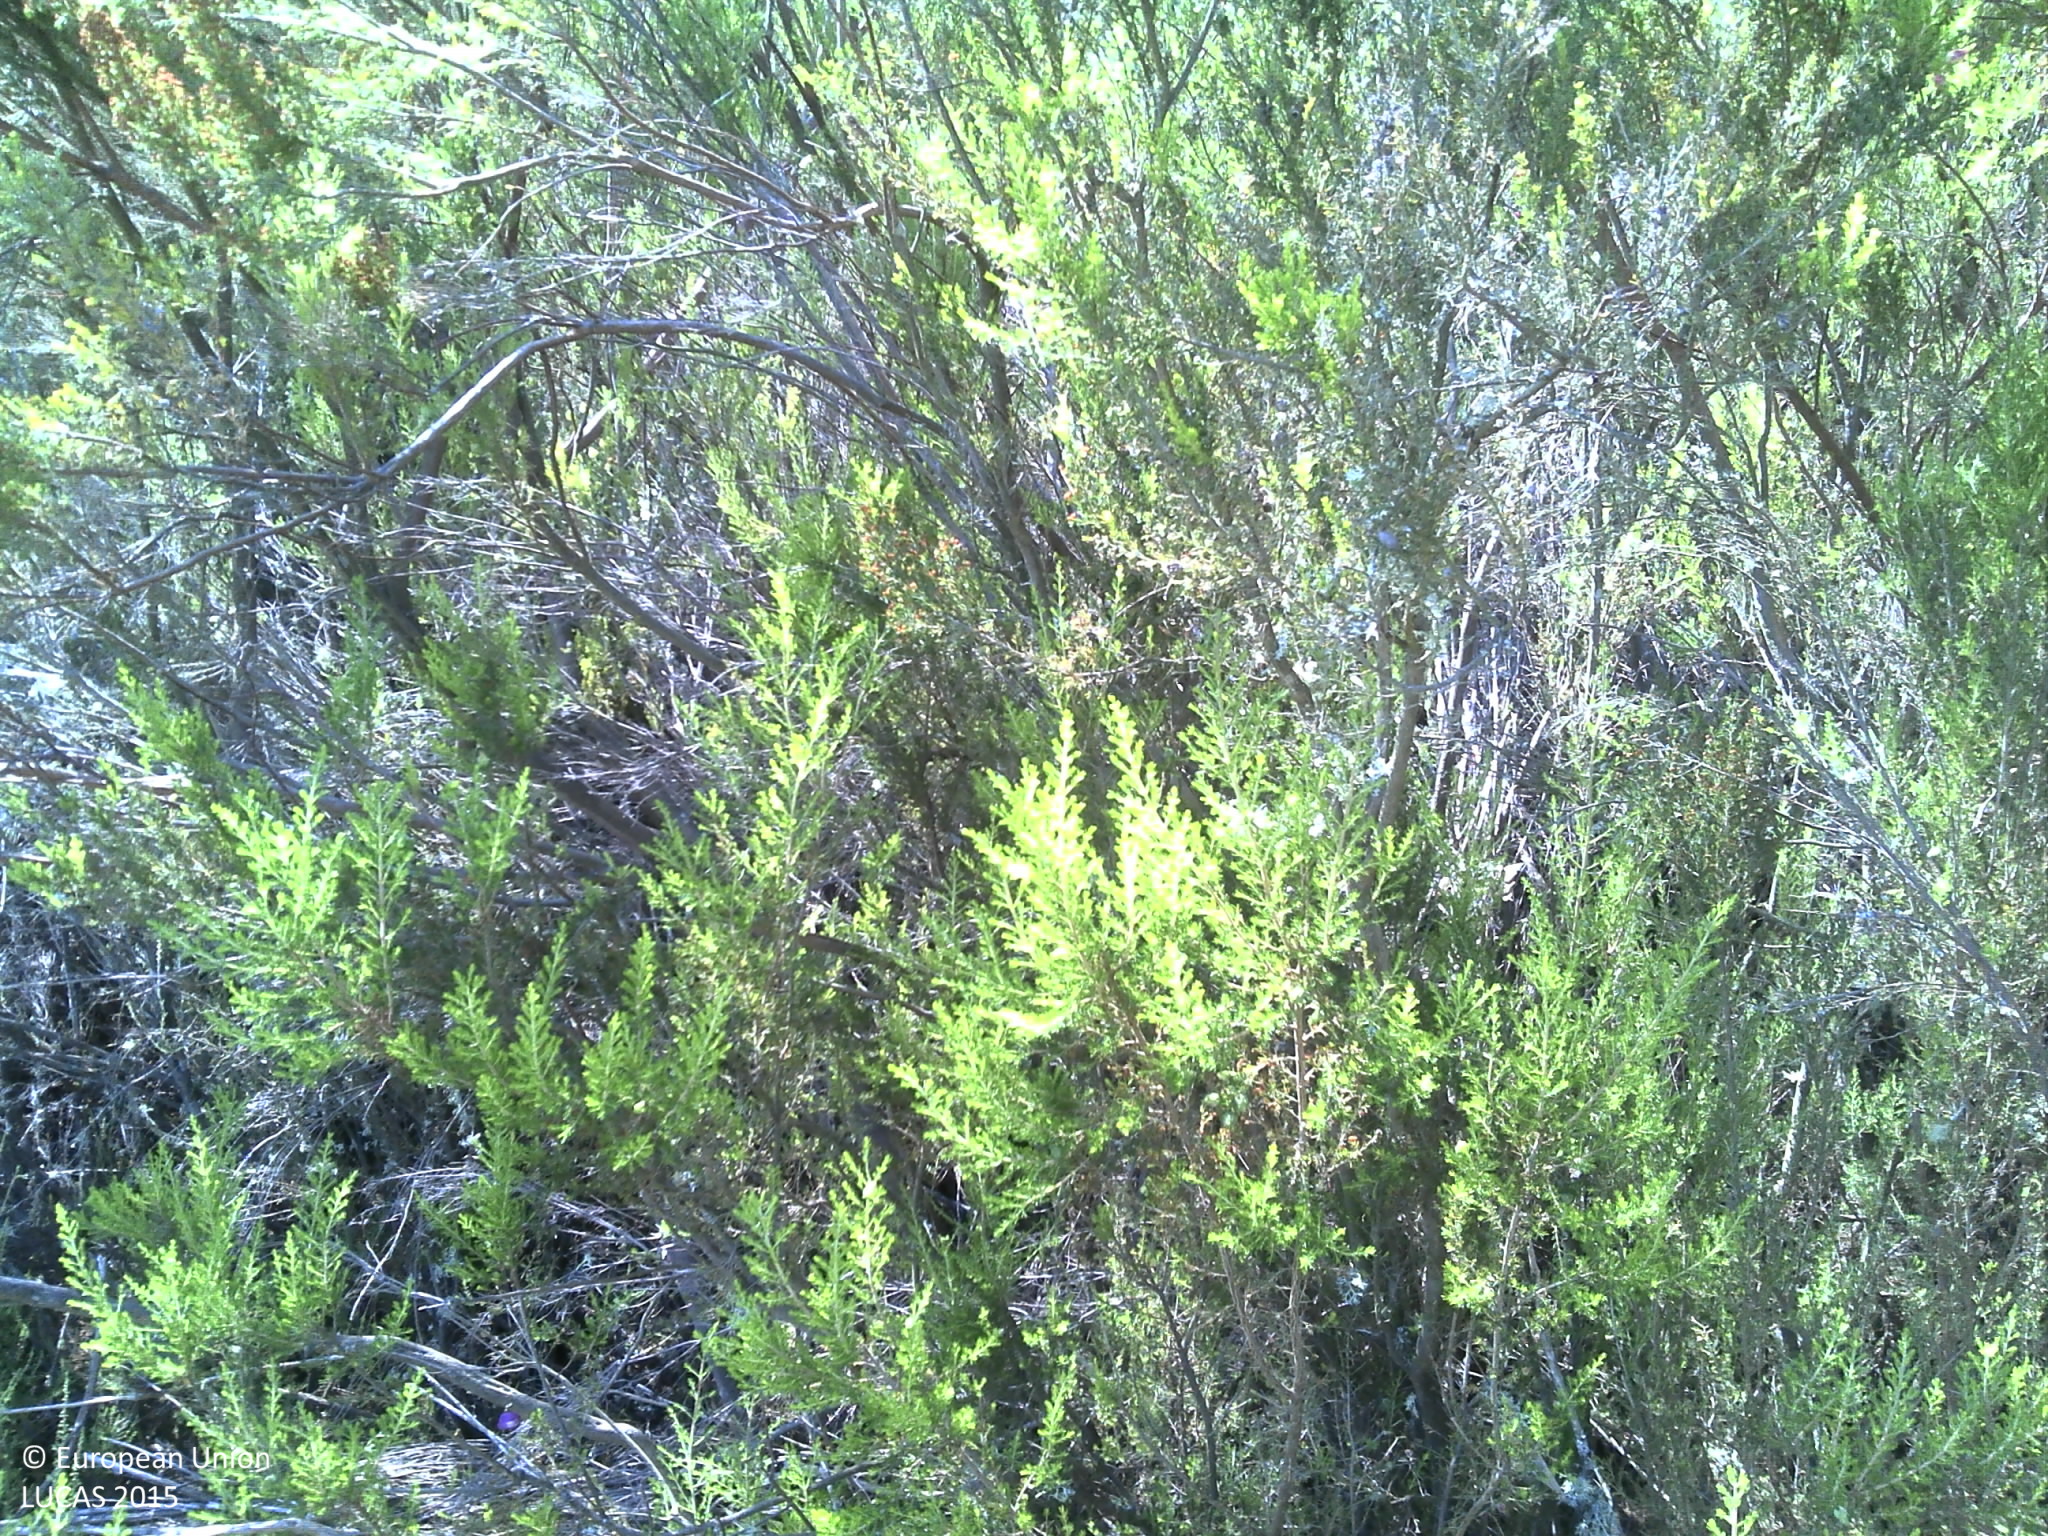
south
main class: Shrubland
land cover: Shrubland without tree cover
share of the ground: > 75 %
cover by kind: shrubs 95 %, herbaceous plants 5 %
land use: Semi-natural and natural areas not in use
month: July
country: PT
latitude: 41.8789
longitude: -7.6703
